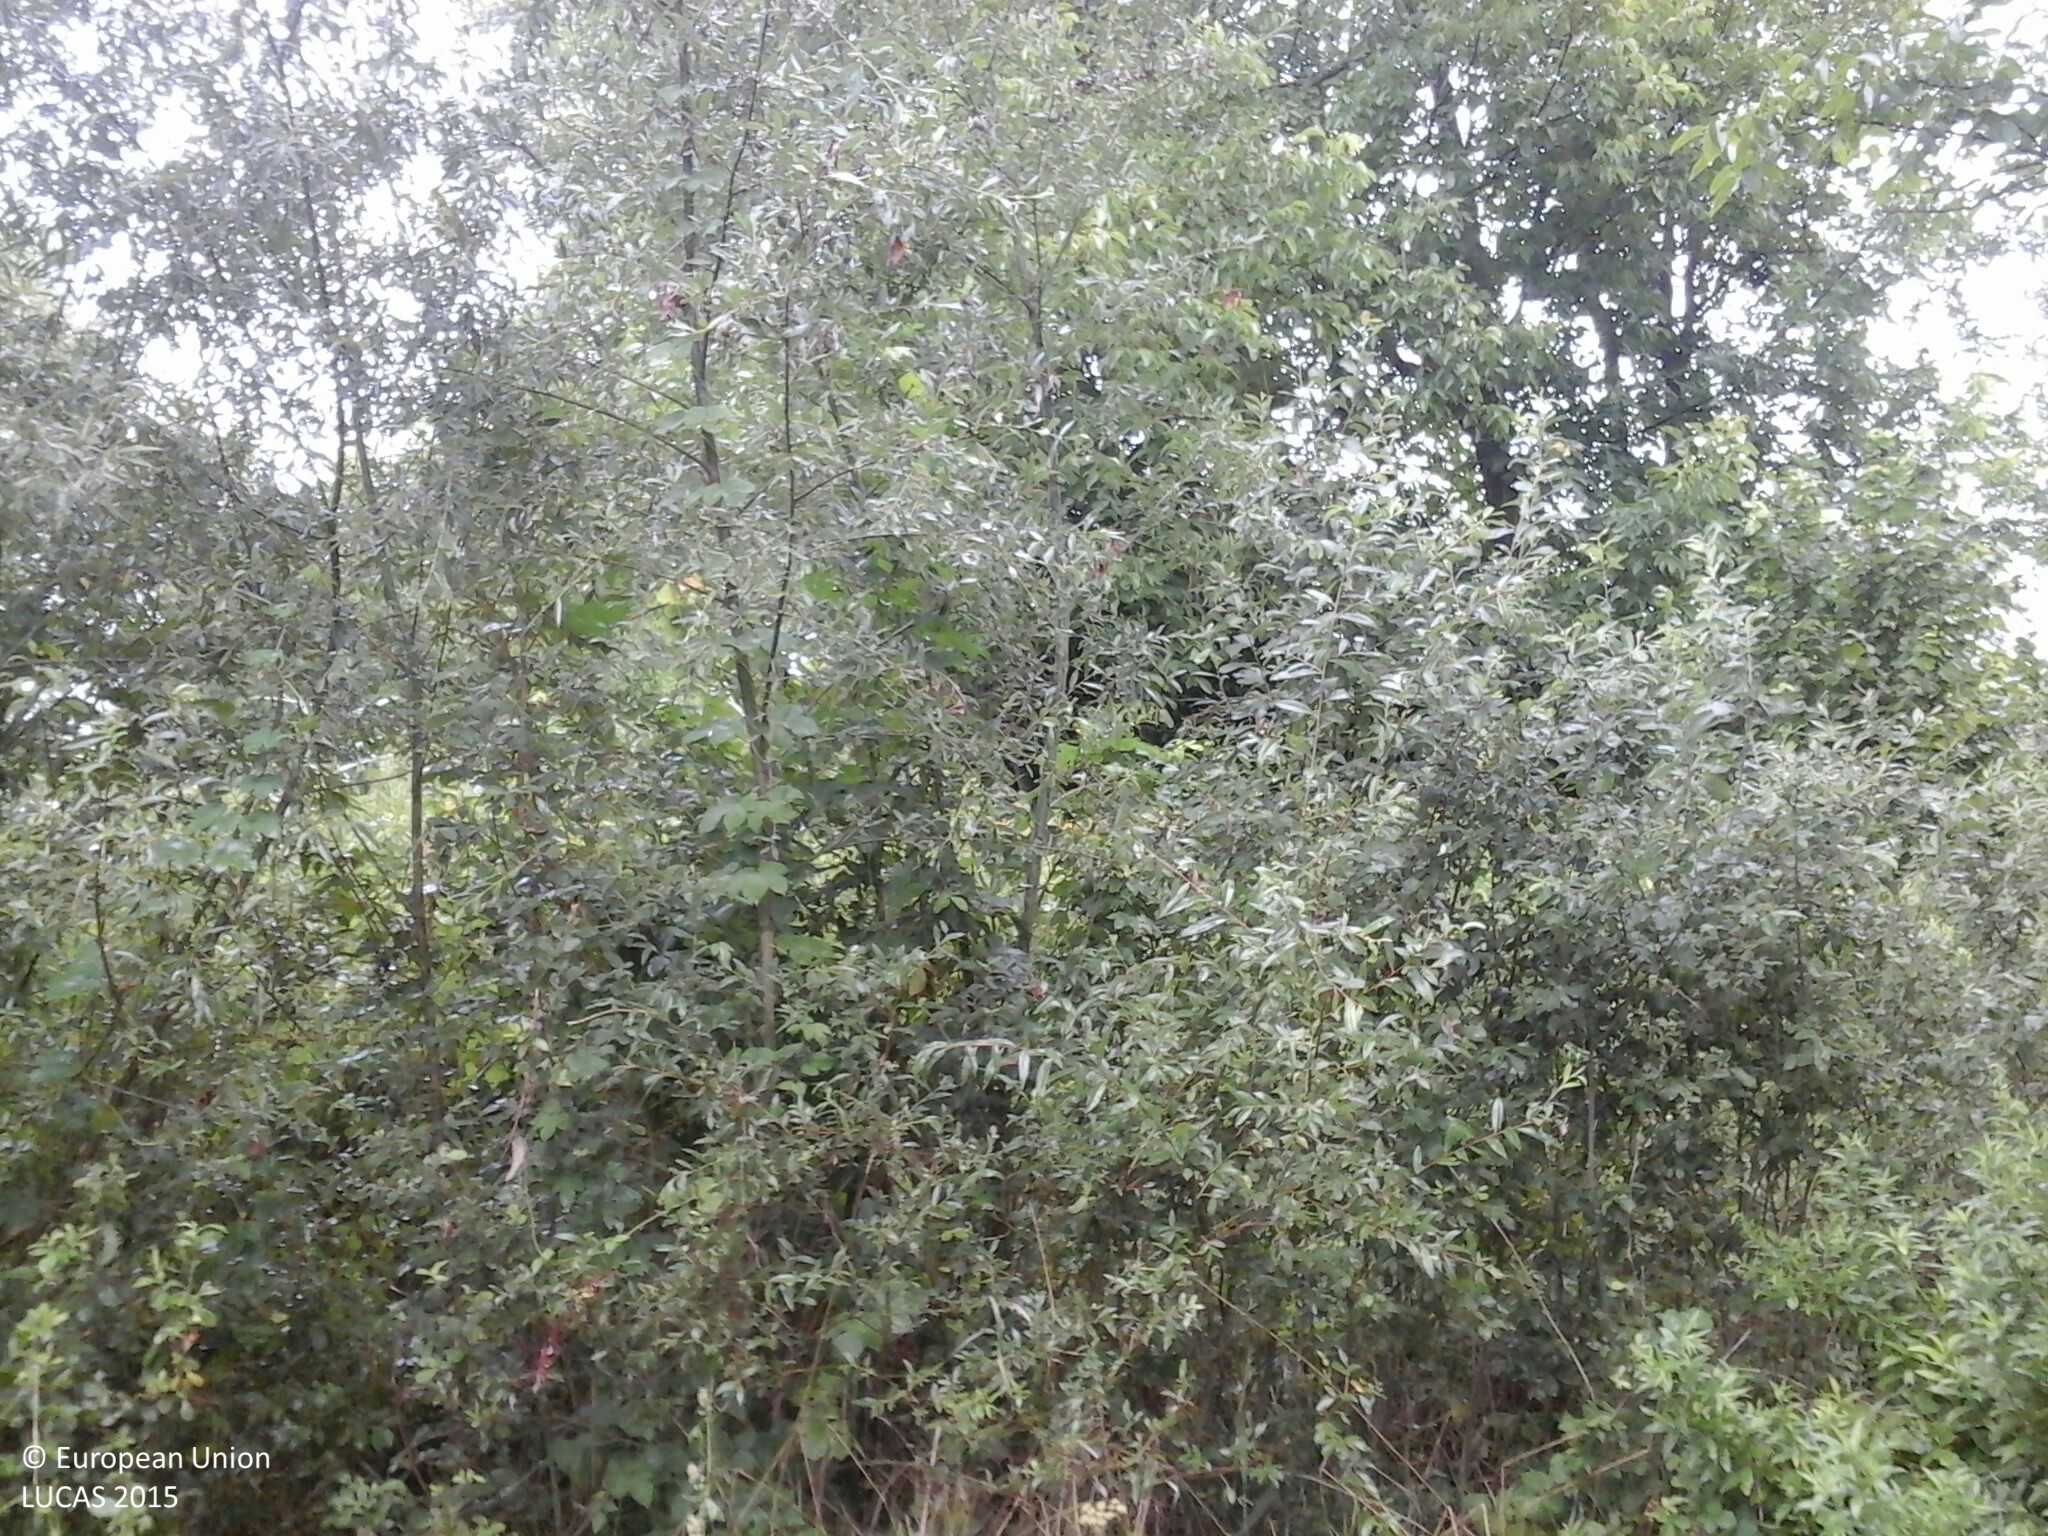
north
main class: Shrubland
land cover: Shrubland with sparse tree cover
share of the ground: > 75 %
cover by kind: shrubs 50 %, herbaceous plants 45 %, broadleaved forest trees 5 %
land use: Abandoned areas
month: July
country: HU
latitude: 46.7500
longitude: 17.8486
